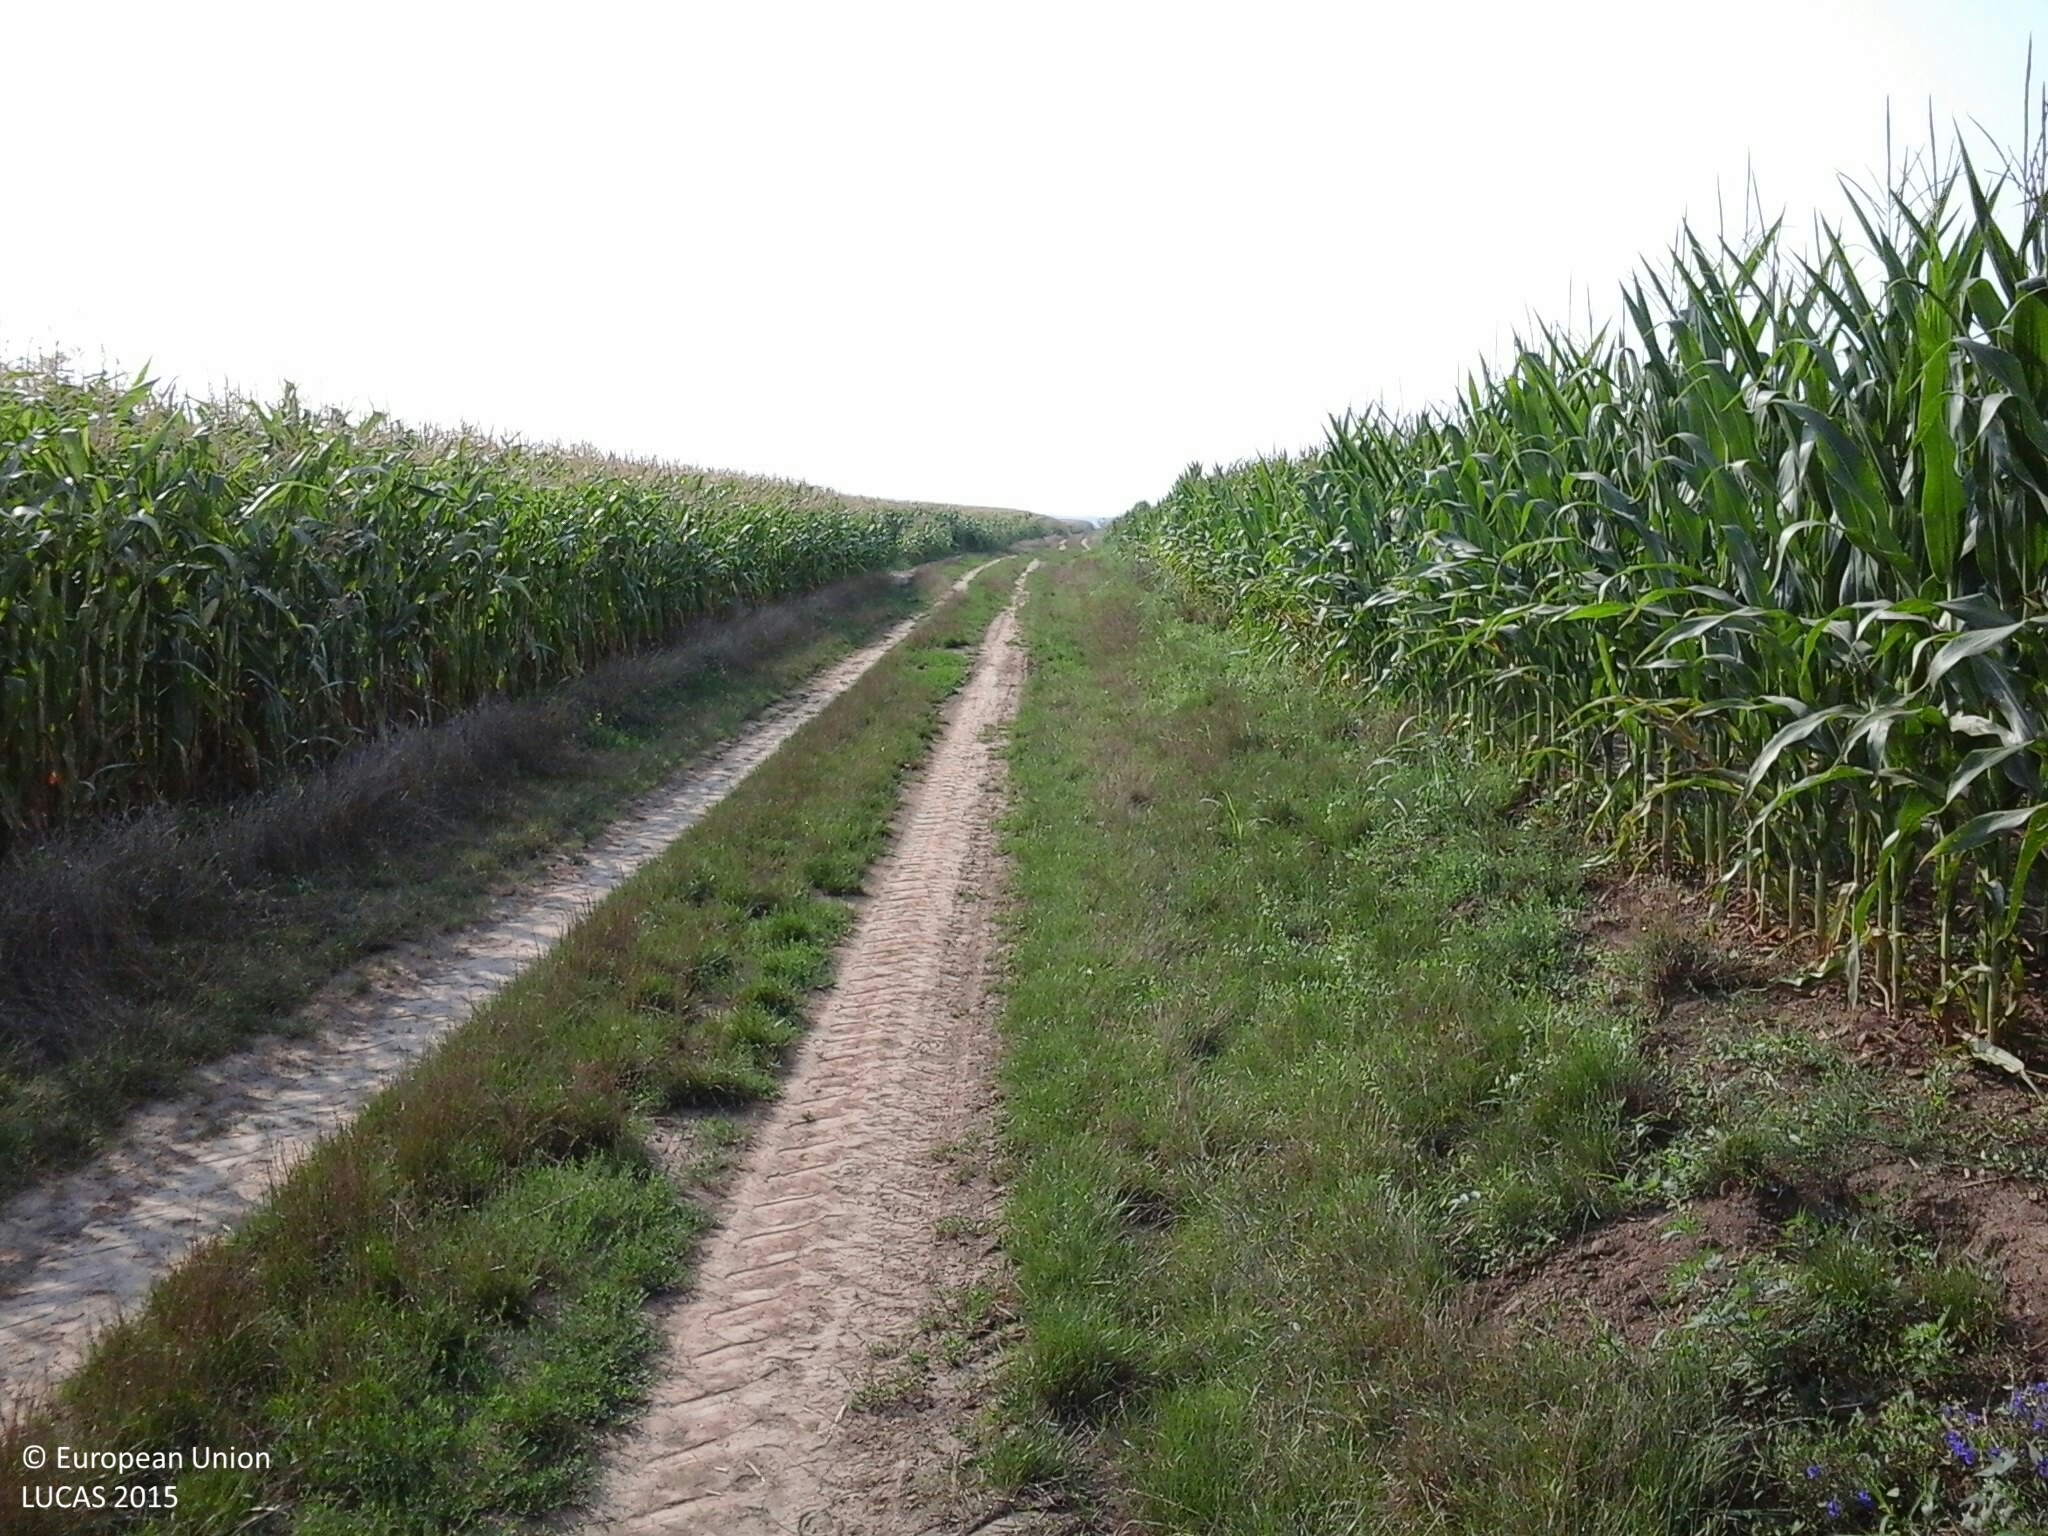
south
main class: Cropland
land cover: Maize
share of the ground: > 75 %
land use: Agriculture (excluding fallow land and kitchen gardens)
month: August
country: HU
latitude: 46.6630
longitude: 18.0459
